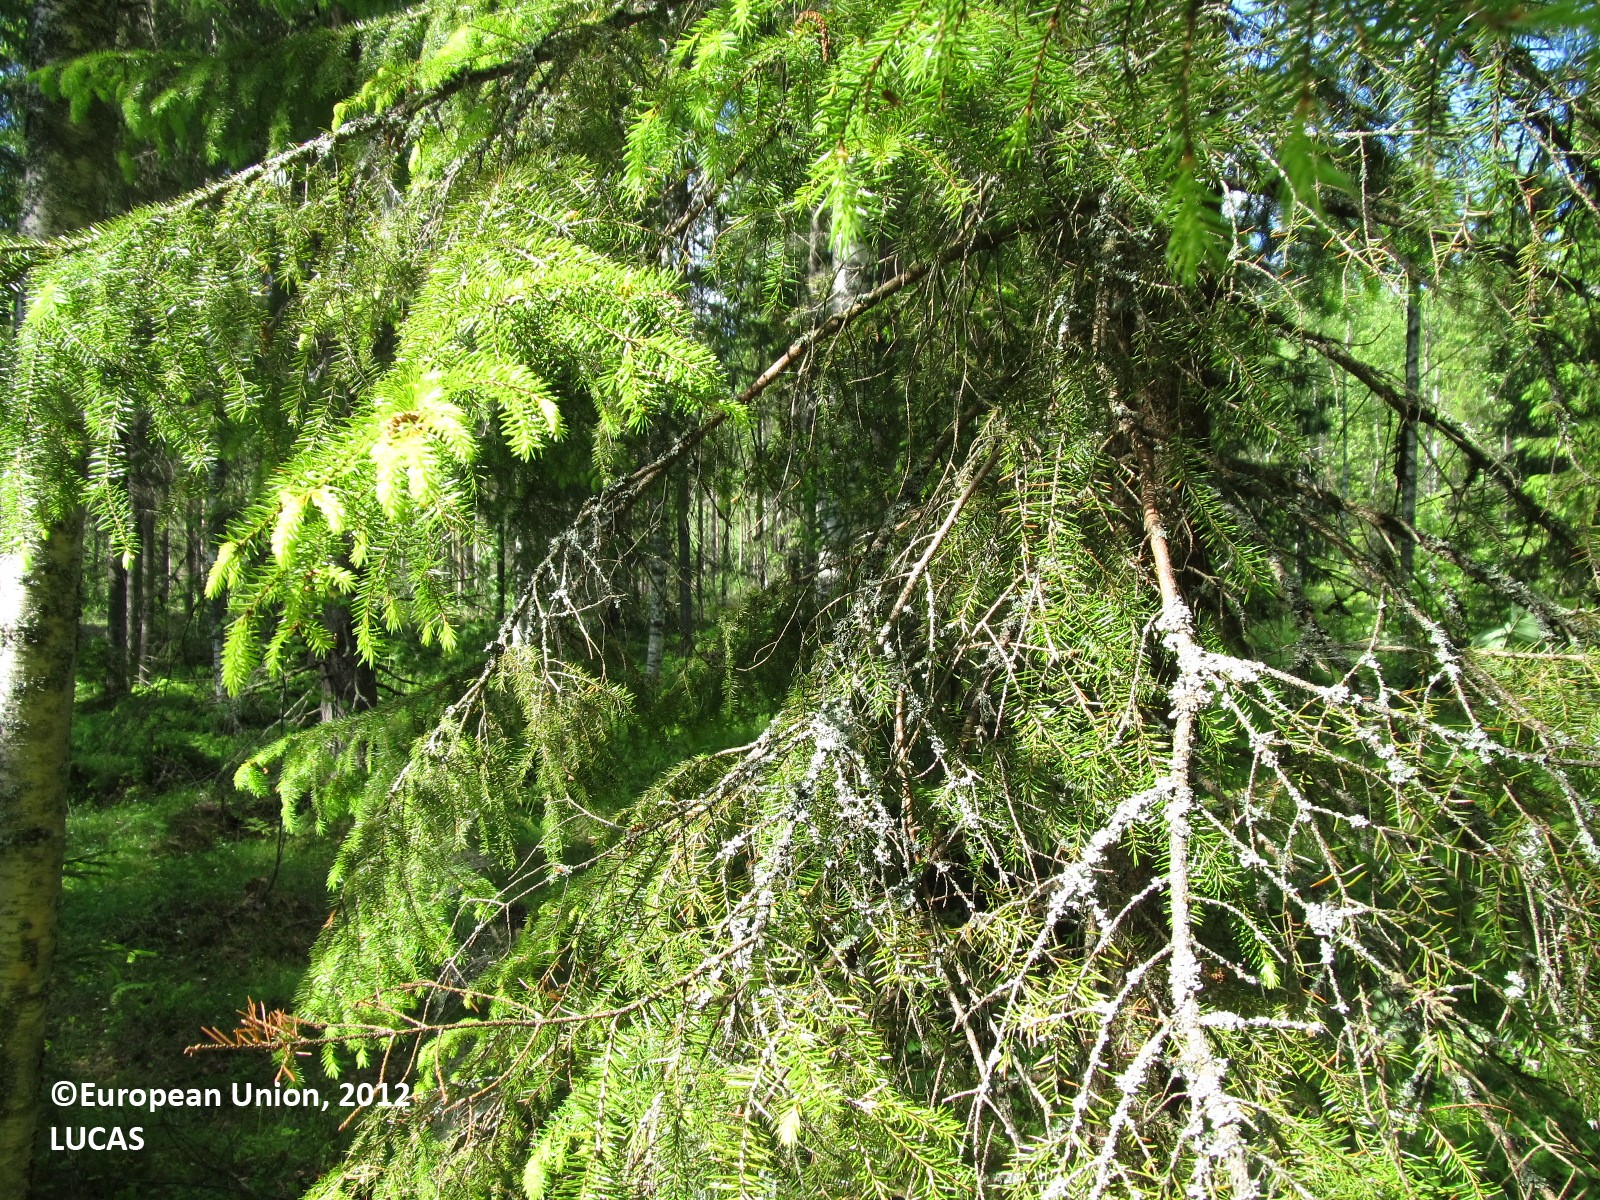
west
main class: Woodland
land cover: Broadleaved woodland
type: boreal forest
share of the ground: 25 - 50 %
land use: Forestry
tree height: > 5 m
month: June
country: FI
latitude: 62.8061
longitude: 27.6038
